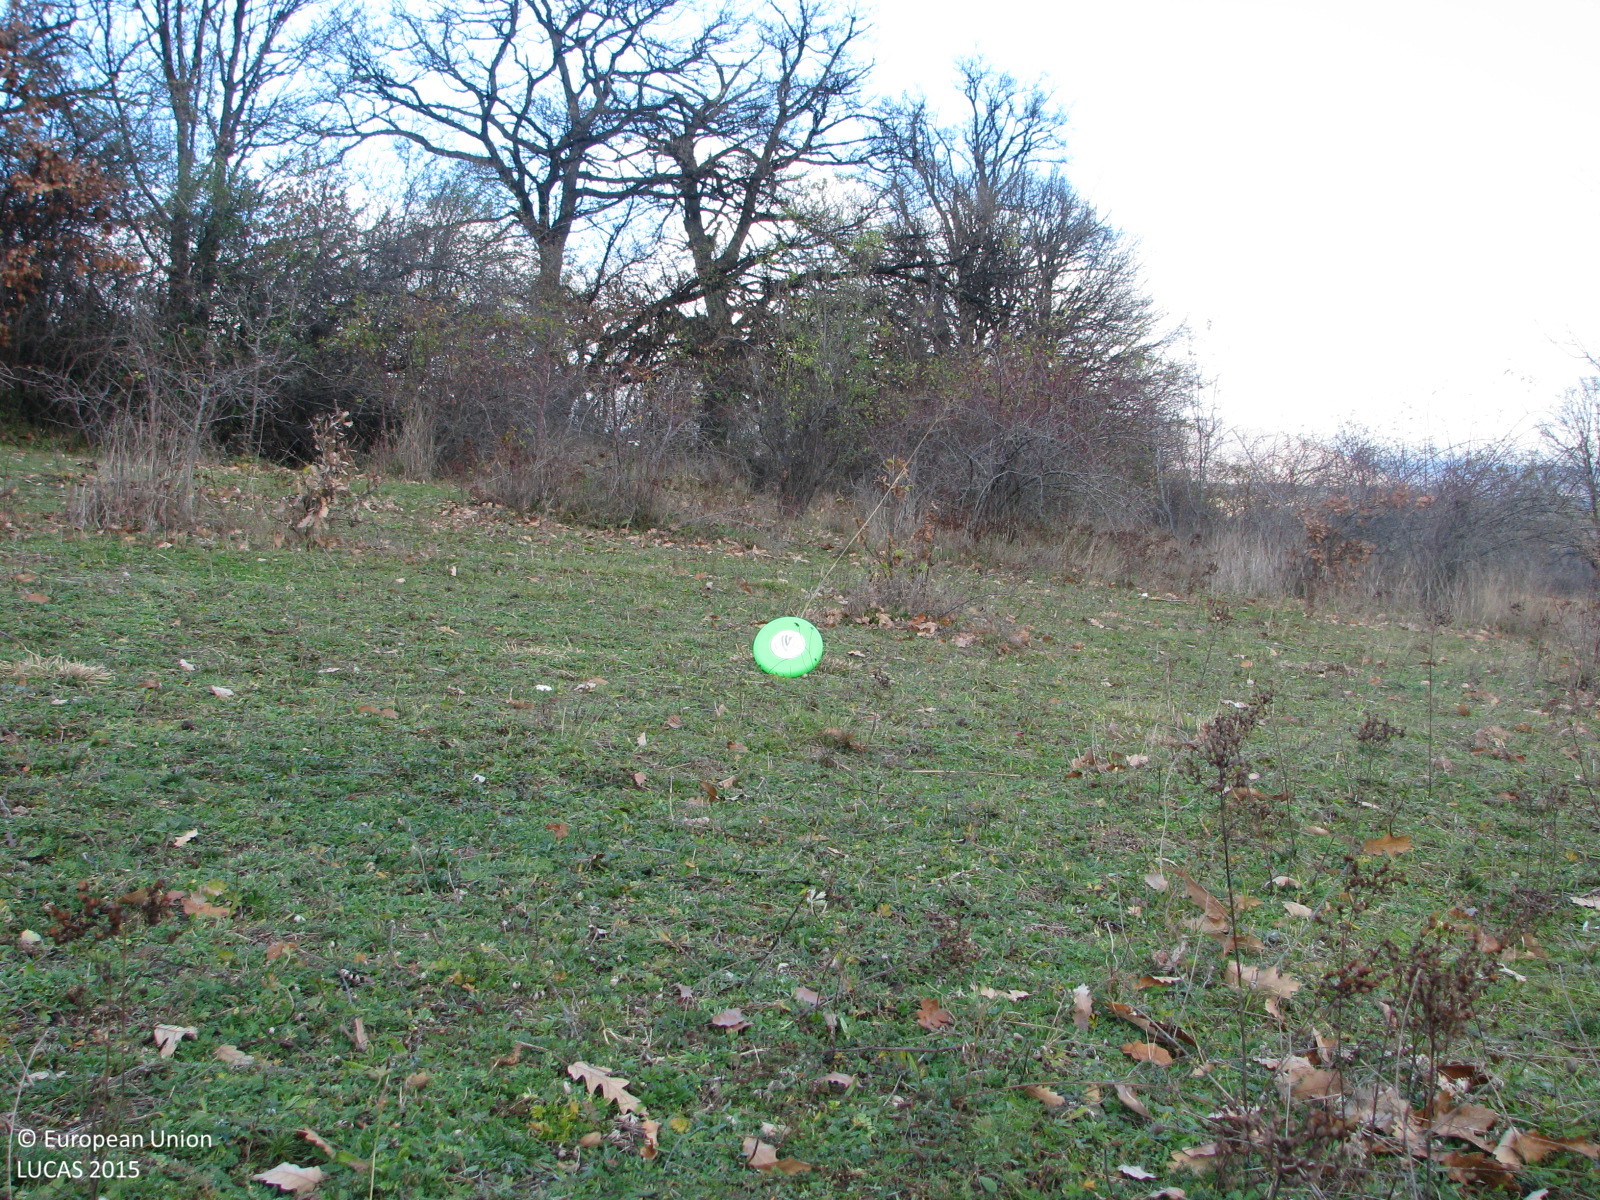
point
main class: Grassland
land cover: Grassland with sparse tree/shrub cover
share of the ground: > 75 %
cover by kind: herbaceous plants 90 %, broadleaved forest trees 5 %, shrubs 5 %
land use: Agriculture (excluding fallow land and kitchen gardens)
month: December
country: BG
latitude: 42.5402
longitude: 24.2323
